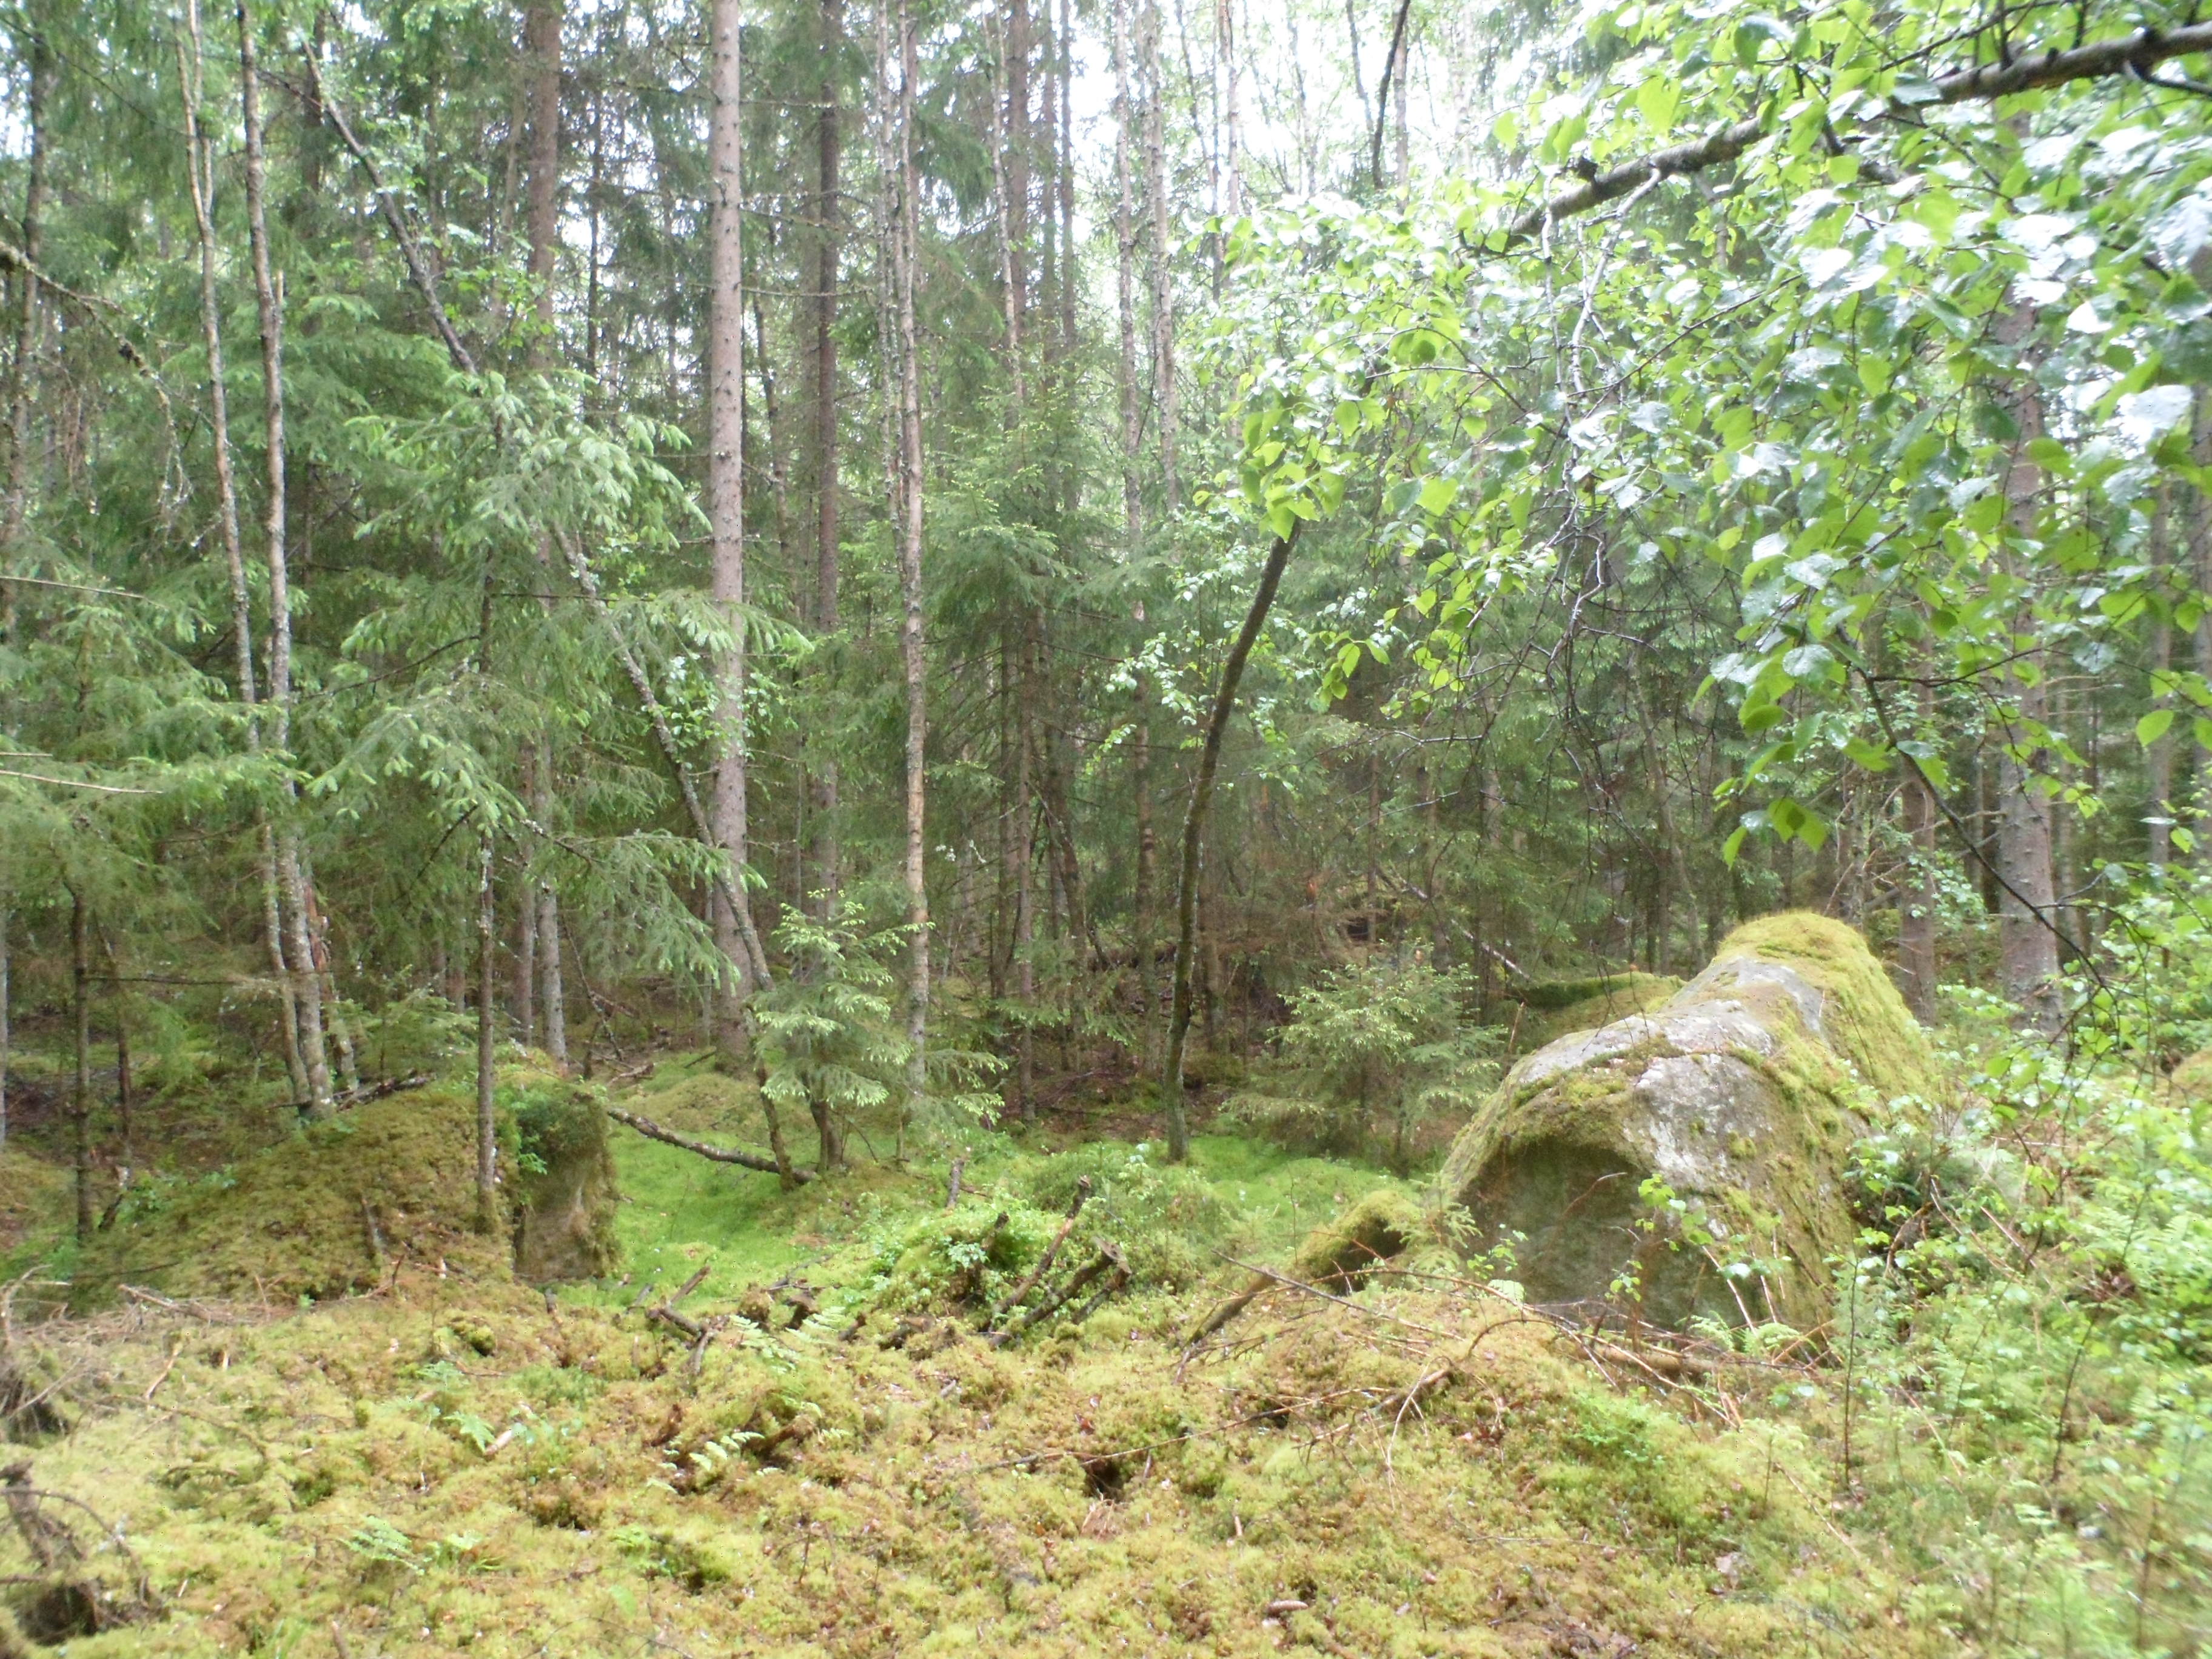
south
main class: Woodland
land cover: Spruce dominated coniferous woodland
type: boreal forest
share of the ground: > 75 %
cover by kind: coniferous forest trees 75 %, lichens and mosses 20 %, broadleaved forest trees 5 %
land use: Forestry
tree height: > 5 m
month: June
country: SE
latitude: 56.8291
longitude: 14.5035
